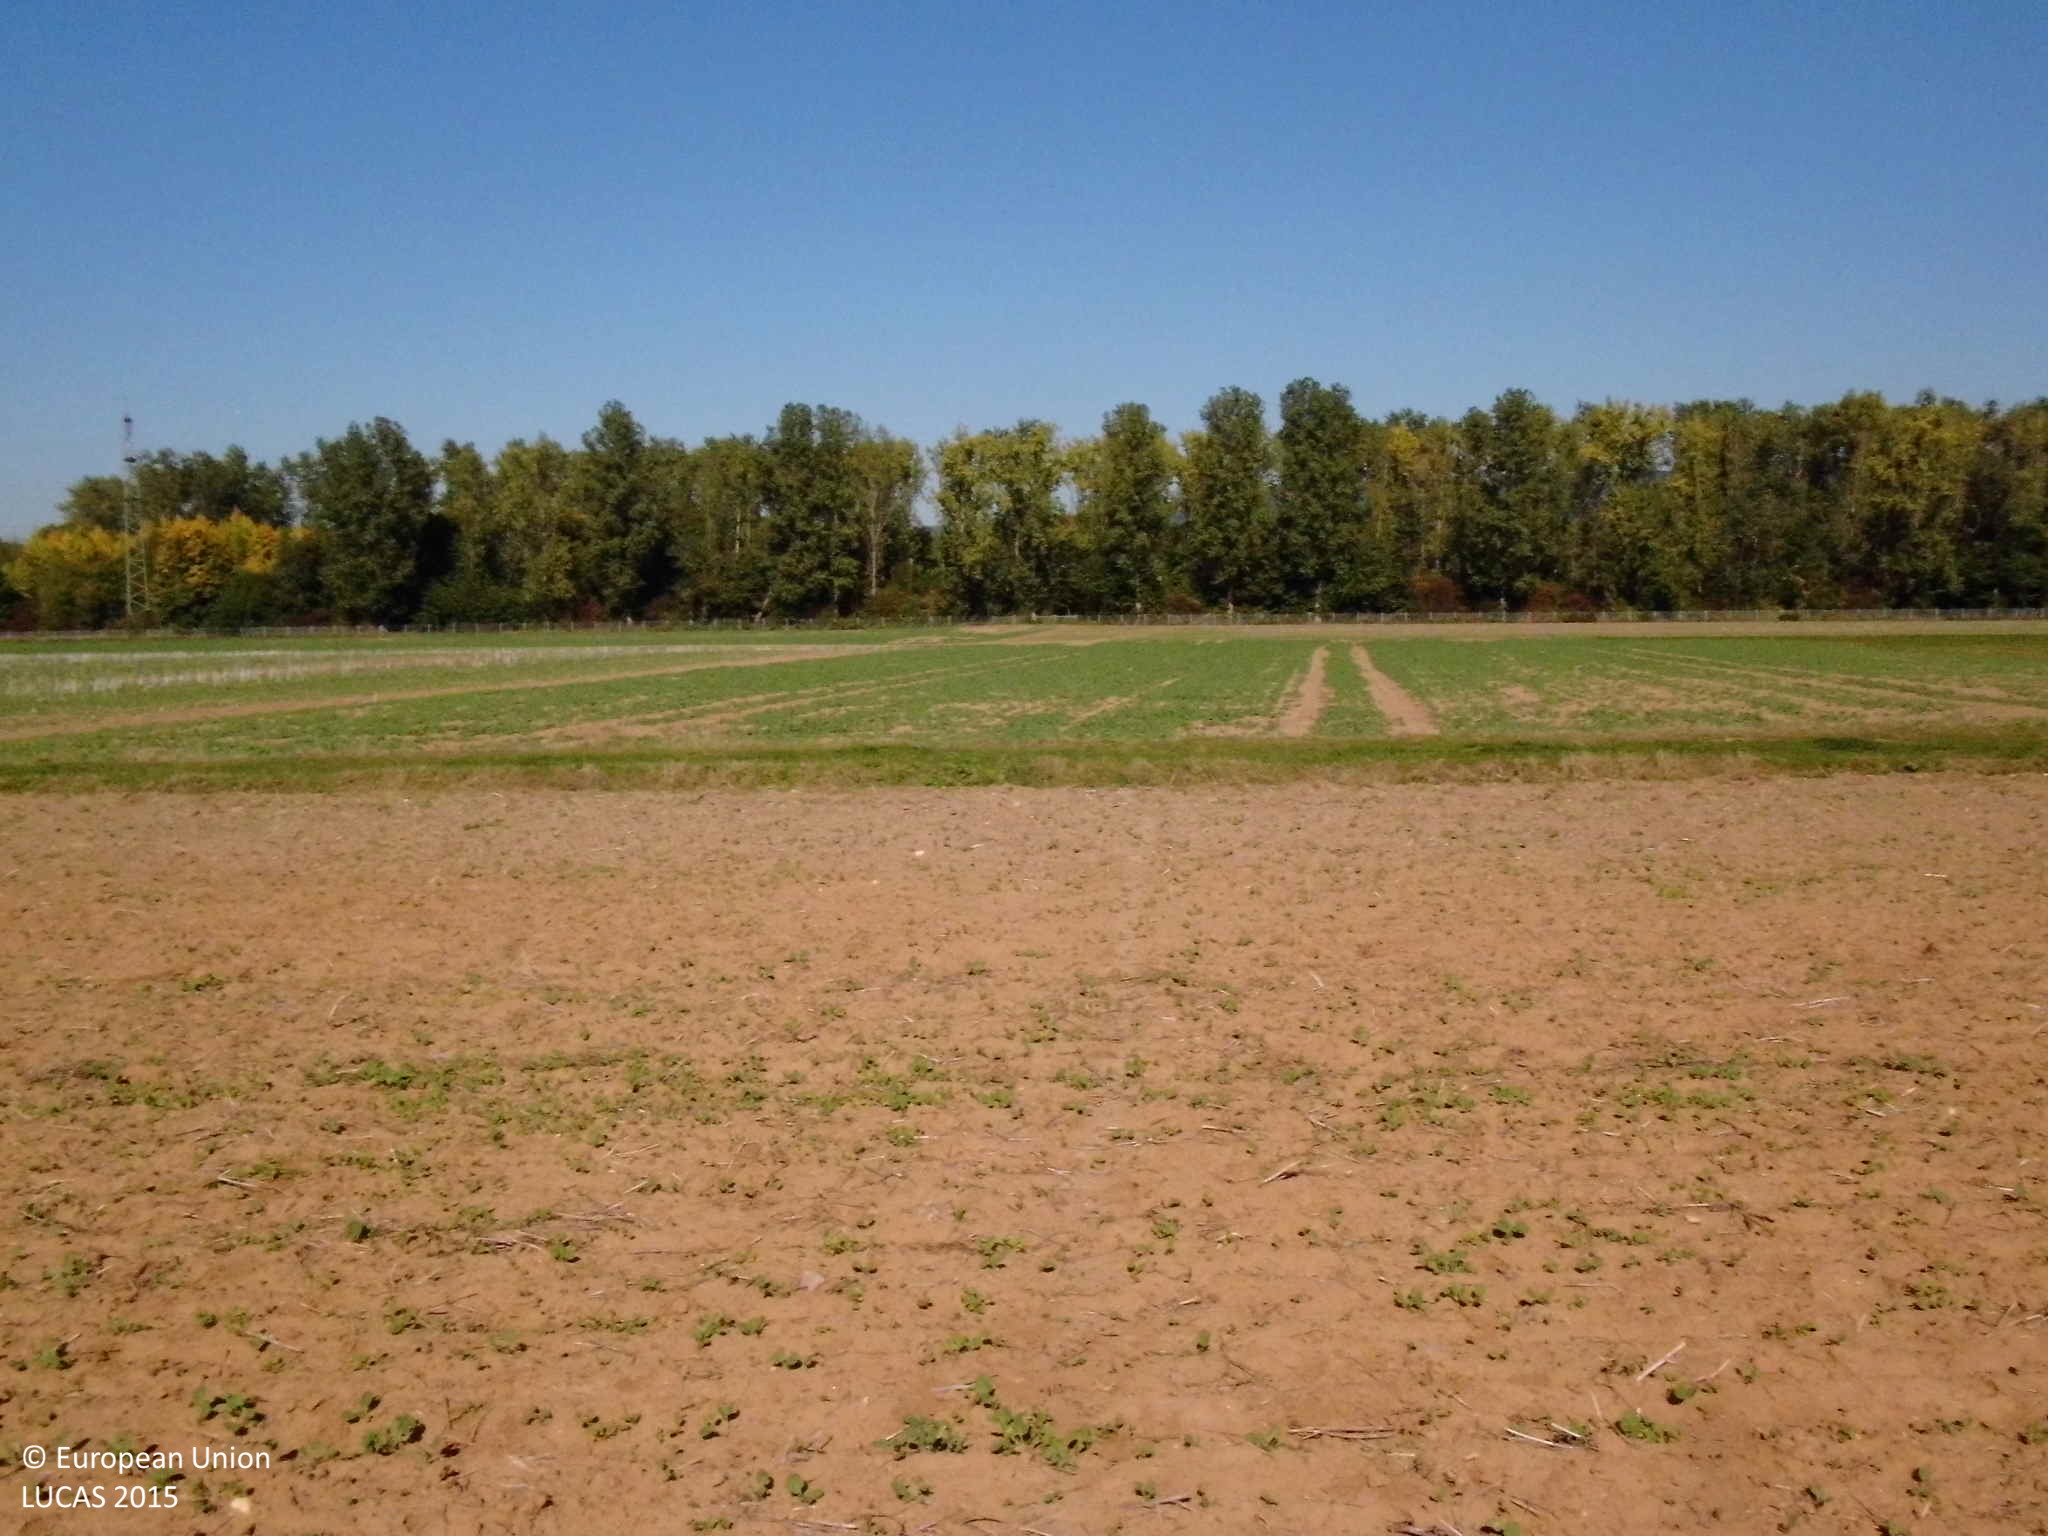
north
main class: Cropland
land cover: Rape and turnip rape
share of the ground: < 10 %
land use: Agriculture (excluding fallow land and kitchen gardens)
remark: Harvested field
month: October
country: DE
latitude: 50.4269
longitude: 7.5087
